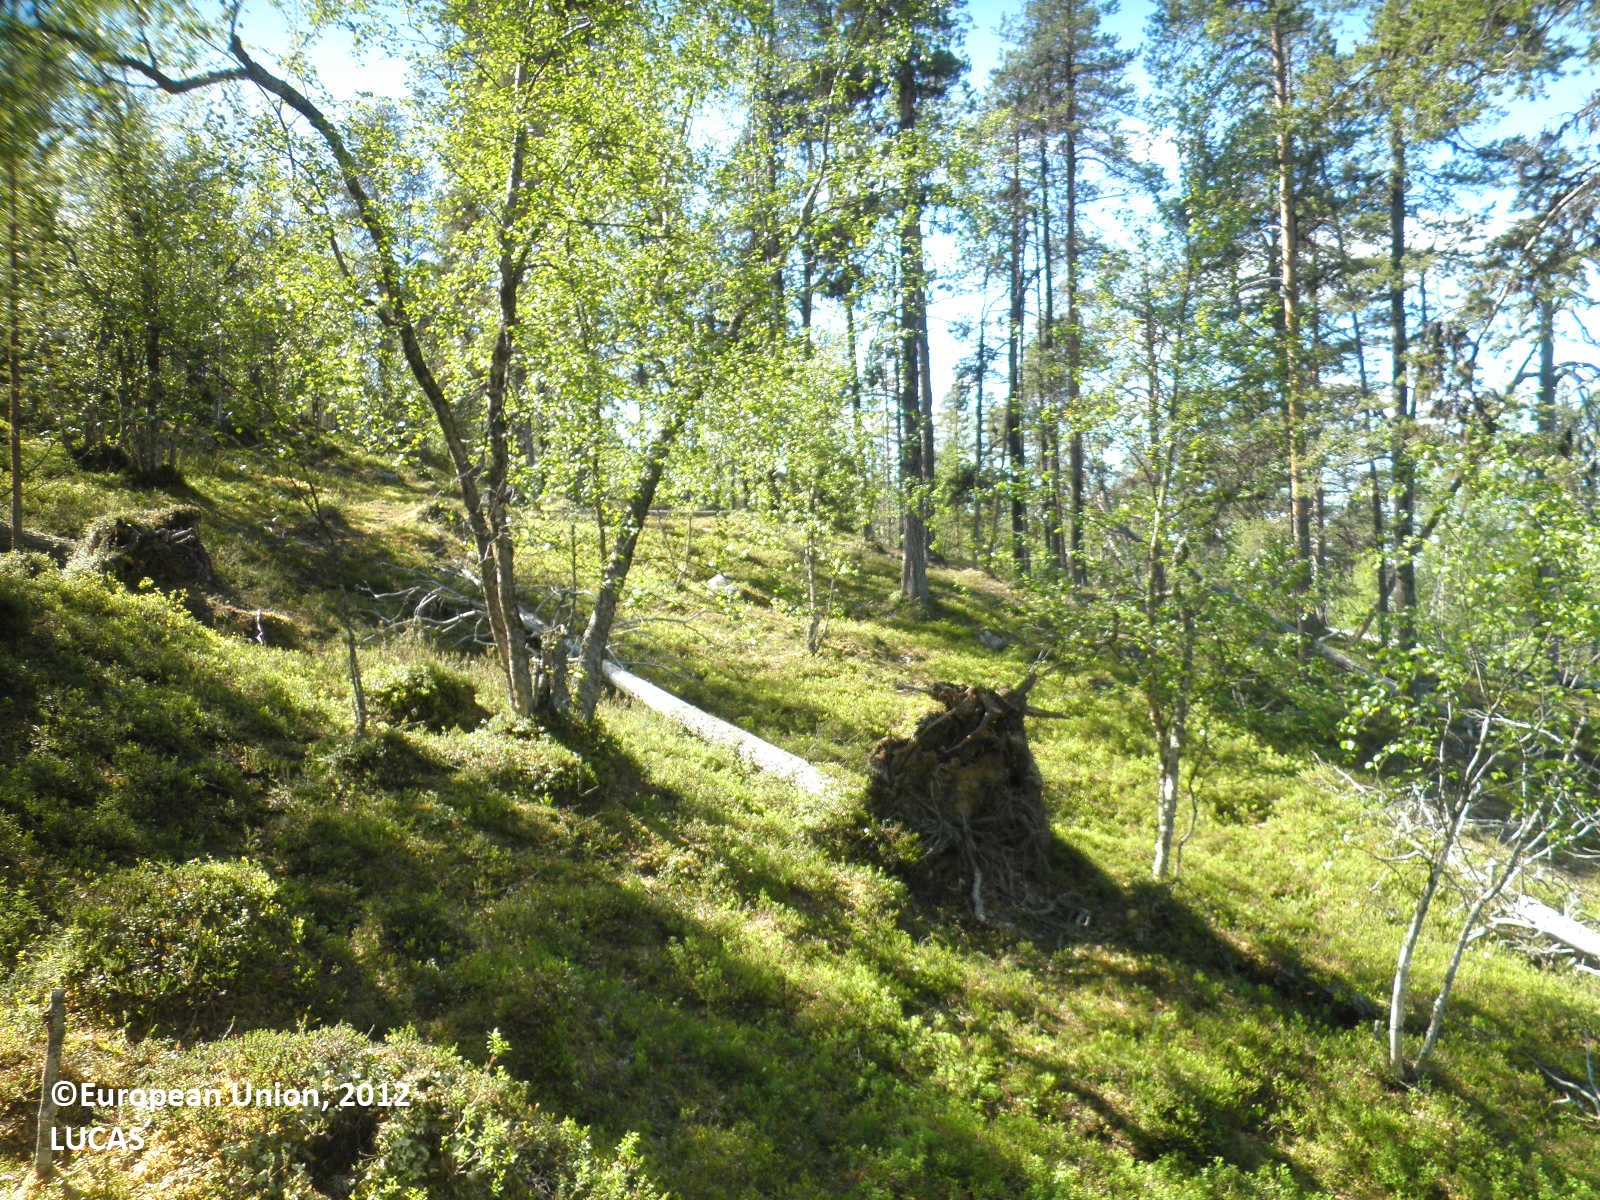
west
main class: Woodland
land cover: Pine dominated mixed woodland
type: boreal forest
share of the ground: 50 - 75 %
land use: Forestry
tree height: > 5 m
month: July
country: FI
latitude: 68.7795
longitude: 27.0200
